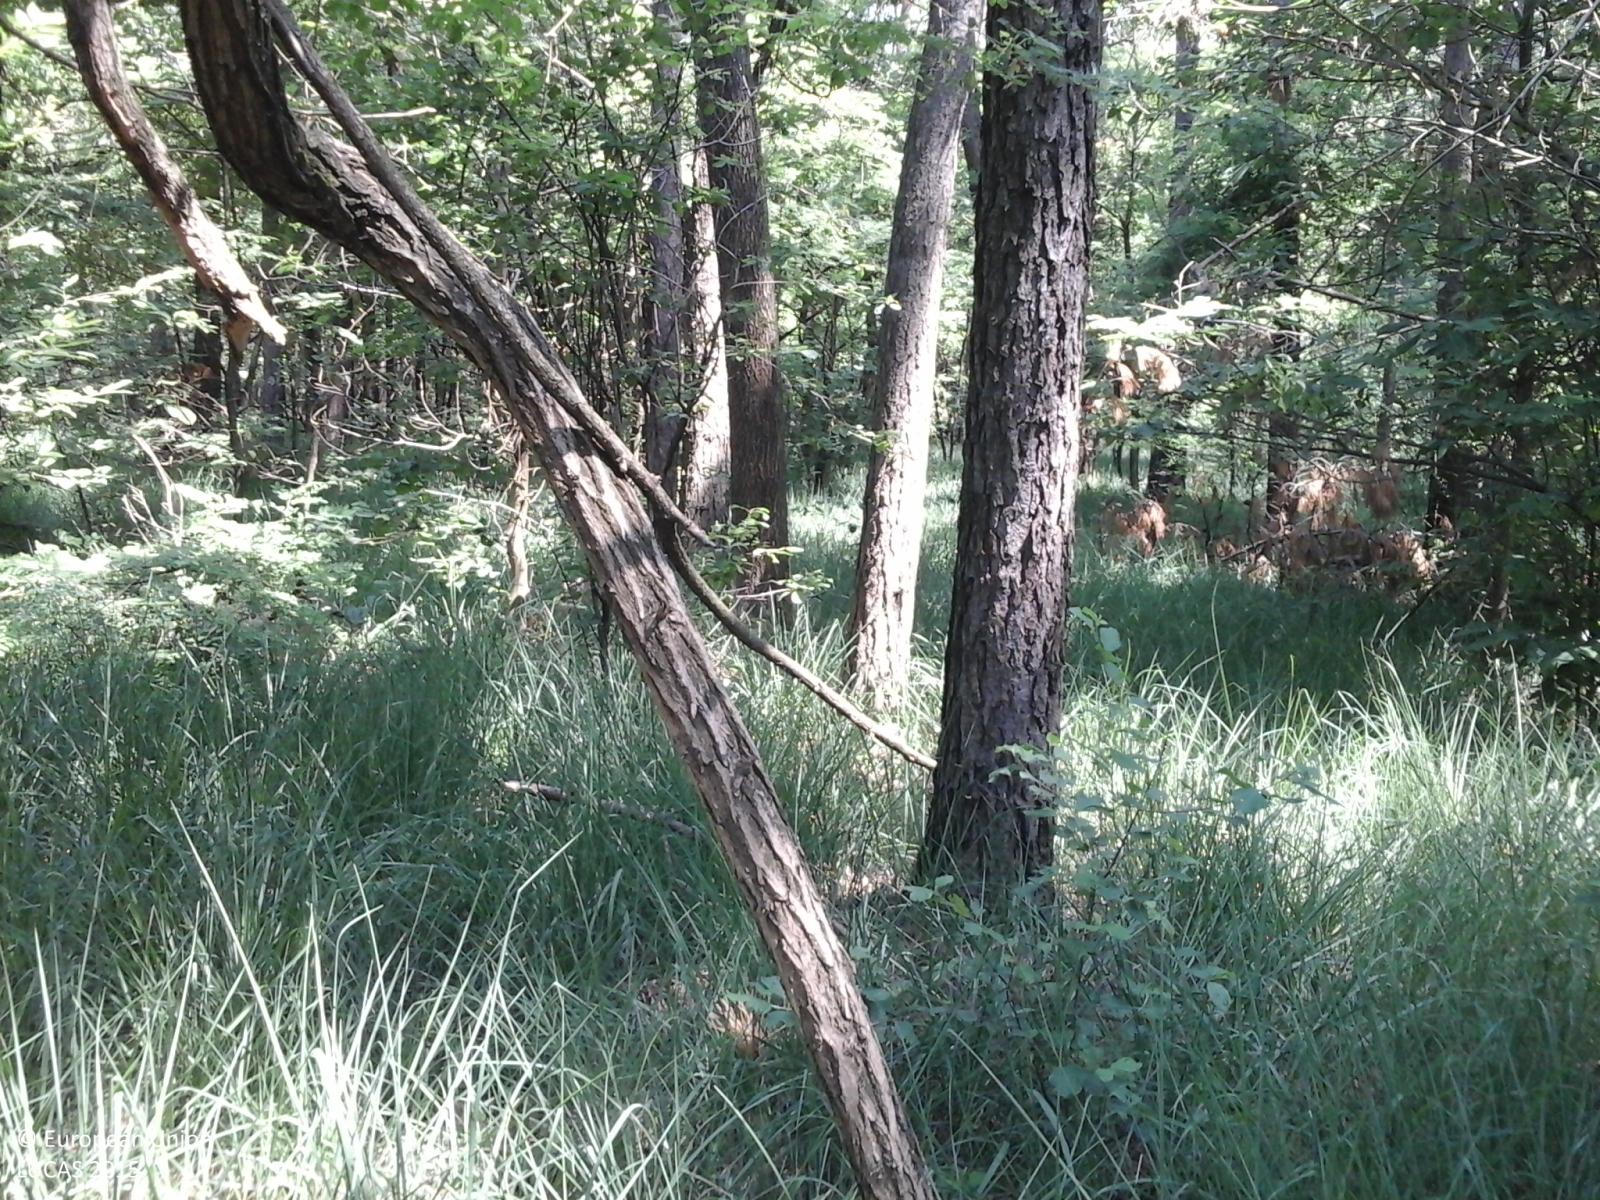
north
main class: Woodland
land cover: Pine dominated mixed woodland
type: thermophilous deciduous forest
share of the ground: > 75 %
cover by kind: coniferous forest trees 75 %, broadleaved forest trees 25 %
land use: Forestry
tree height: > 5 m
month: June
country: IT
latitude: 45.6587
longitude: 8.7059
